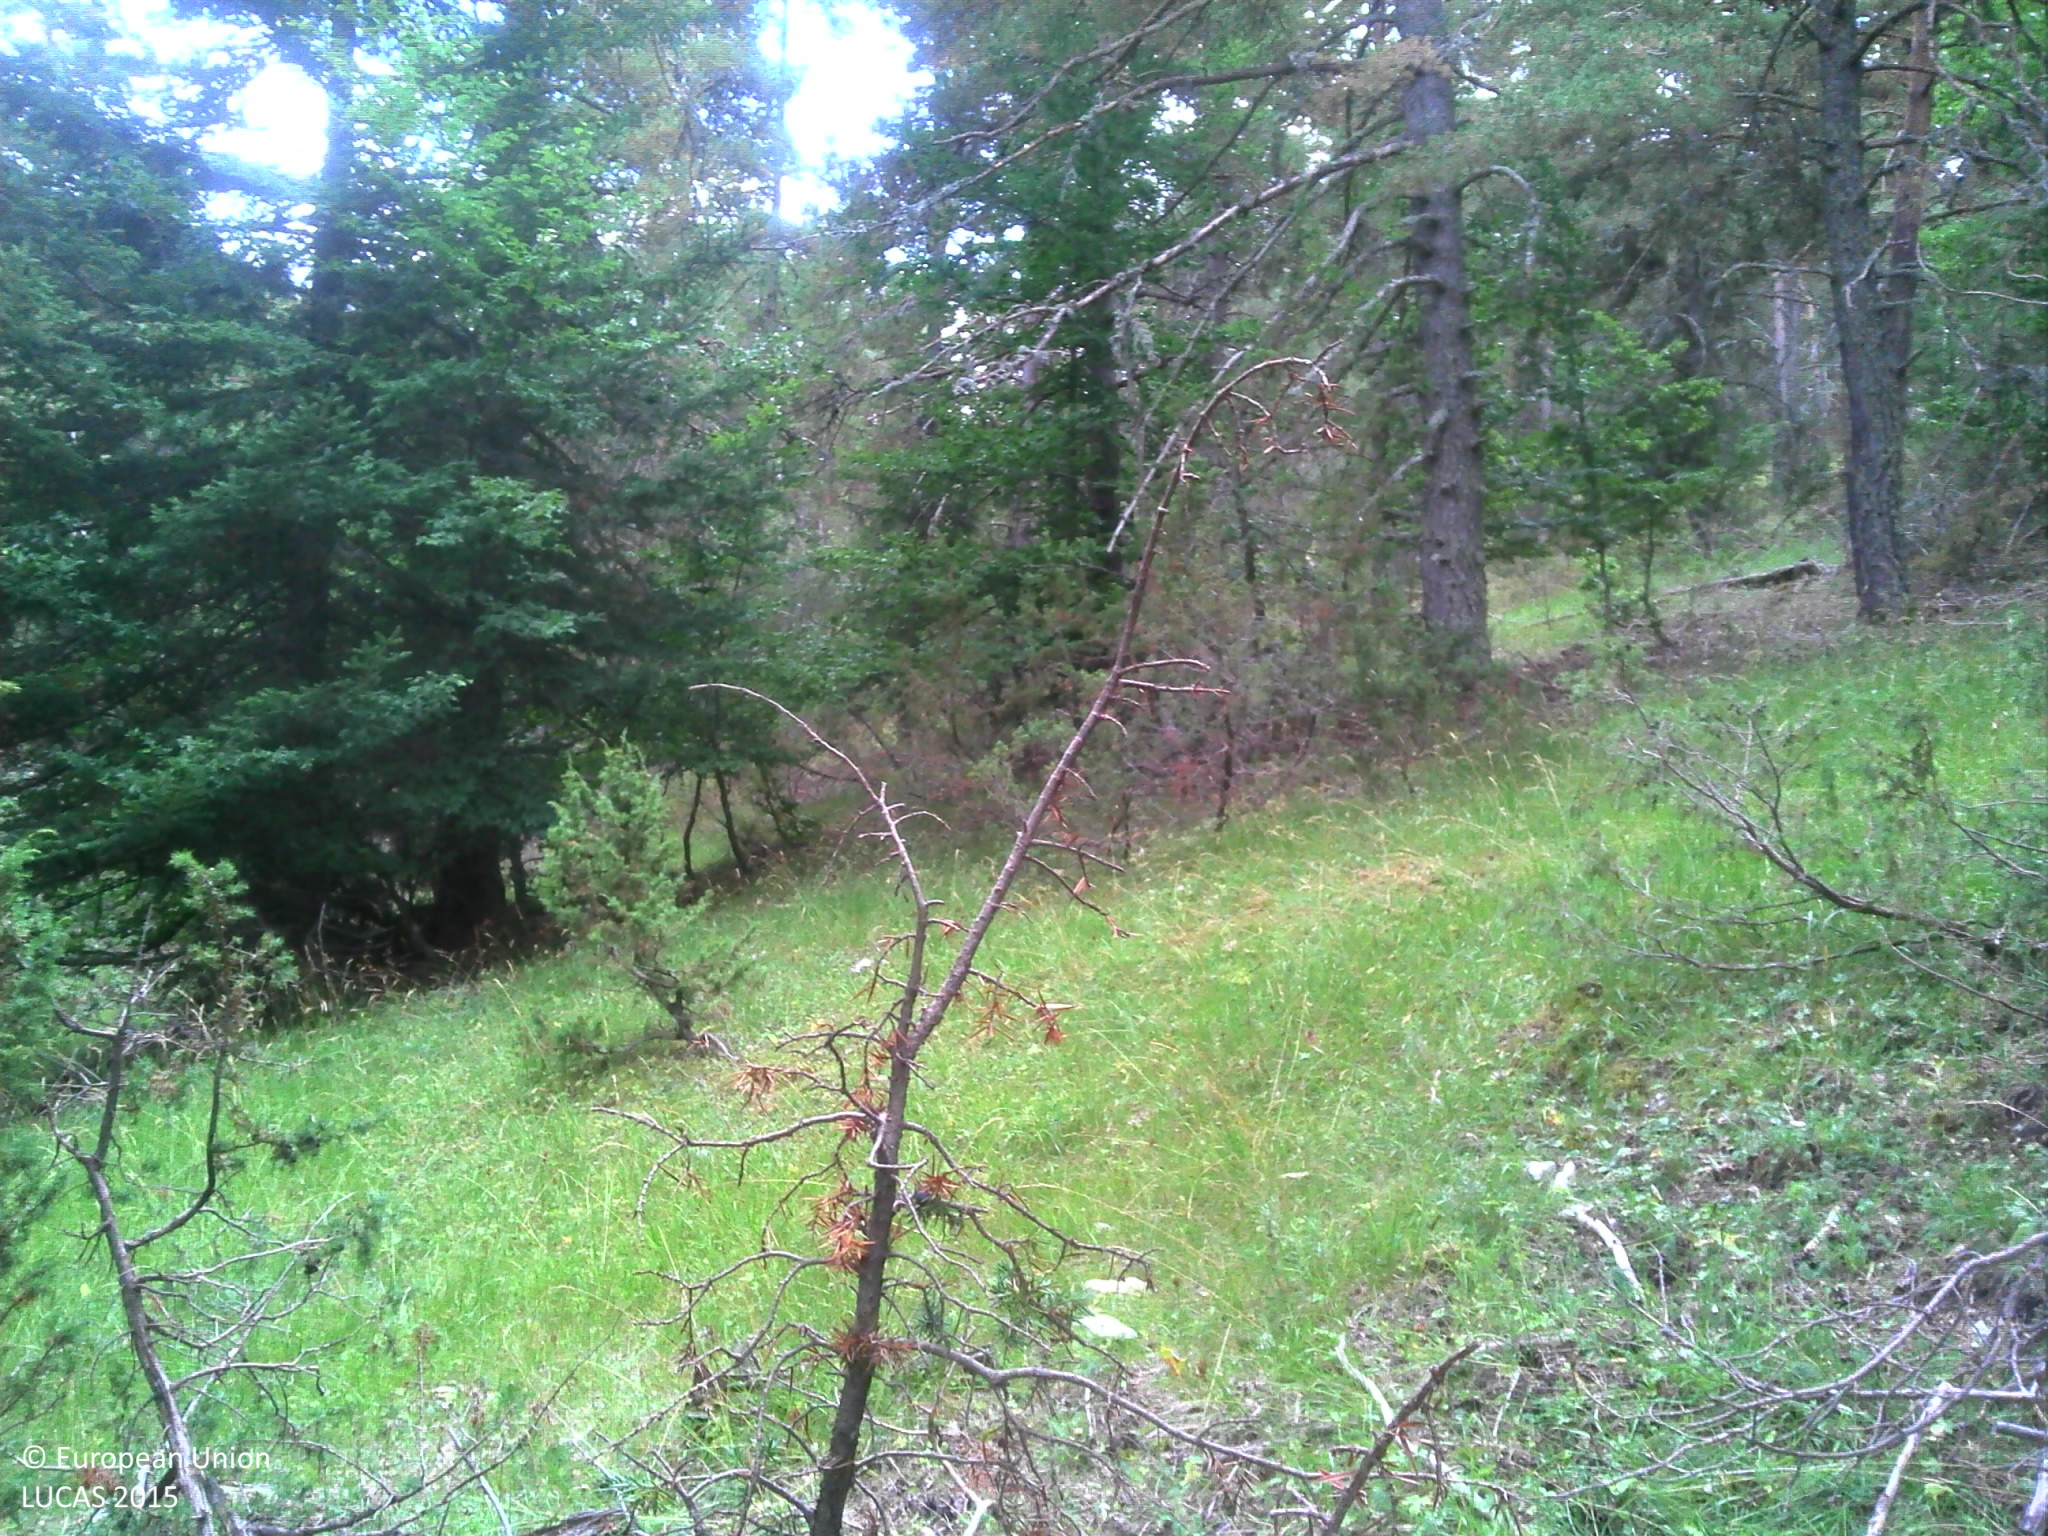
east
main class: Woodland
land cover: Pine dominated coniferous woodland
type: alpine coniferous forest
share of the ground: 50 - 75 %
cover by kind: coniferous forest trees 60 %, herbaceous plants 20 %, broadleaved forest trees 10 %, lichens and mosses 10 %
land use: Forestry
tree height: > 5 m
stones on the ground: 10 - 25 %
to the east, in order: Pine dominated coniferous woodland; Rivers and streams; Pine dominated coniferous woodland; Grassland without tree/shrub cover; Spruce dominated coniferous woodland; Grass margins; Tracks; Grass margins; Pine dominated coniferous woodland; Grassland without tree/shrub cover; Pine dominated coniferous woodland; Grassland with sparse tree/shrub cover
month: August
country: FR
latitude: 44.0602
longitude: 6.5992
